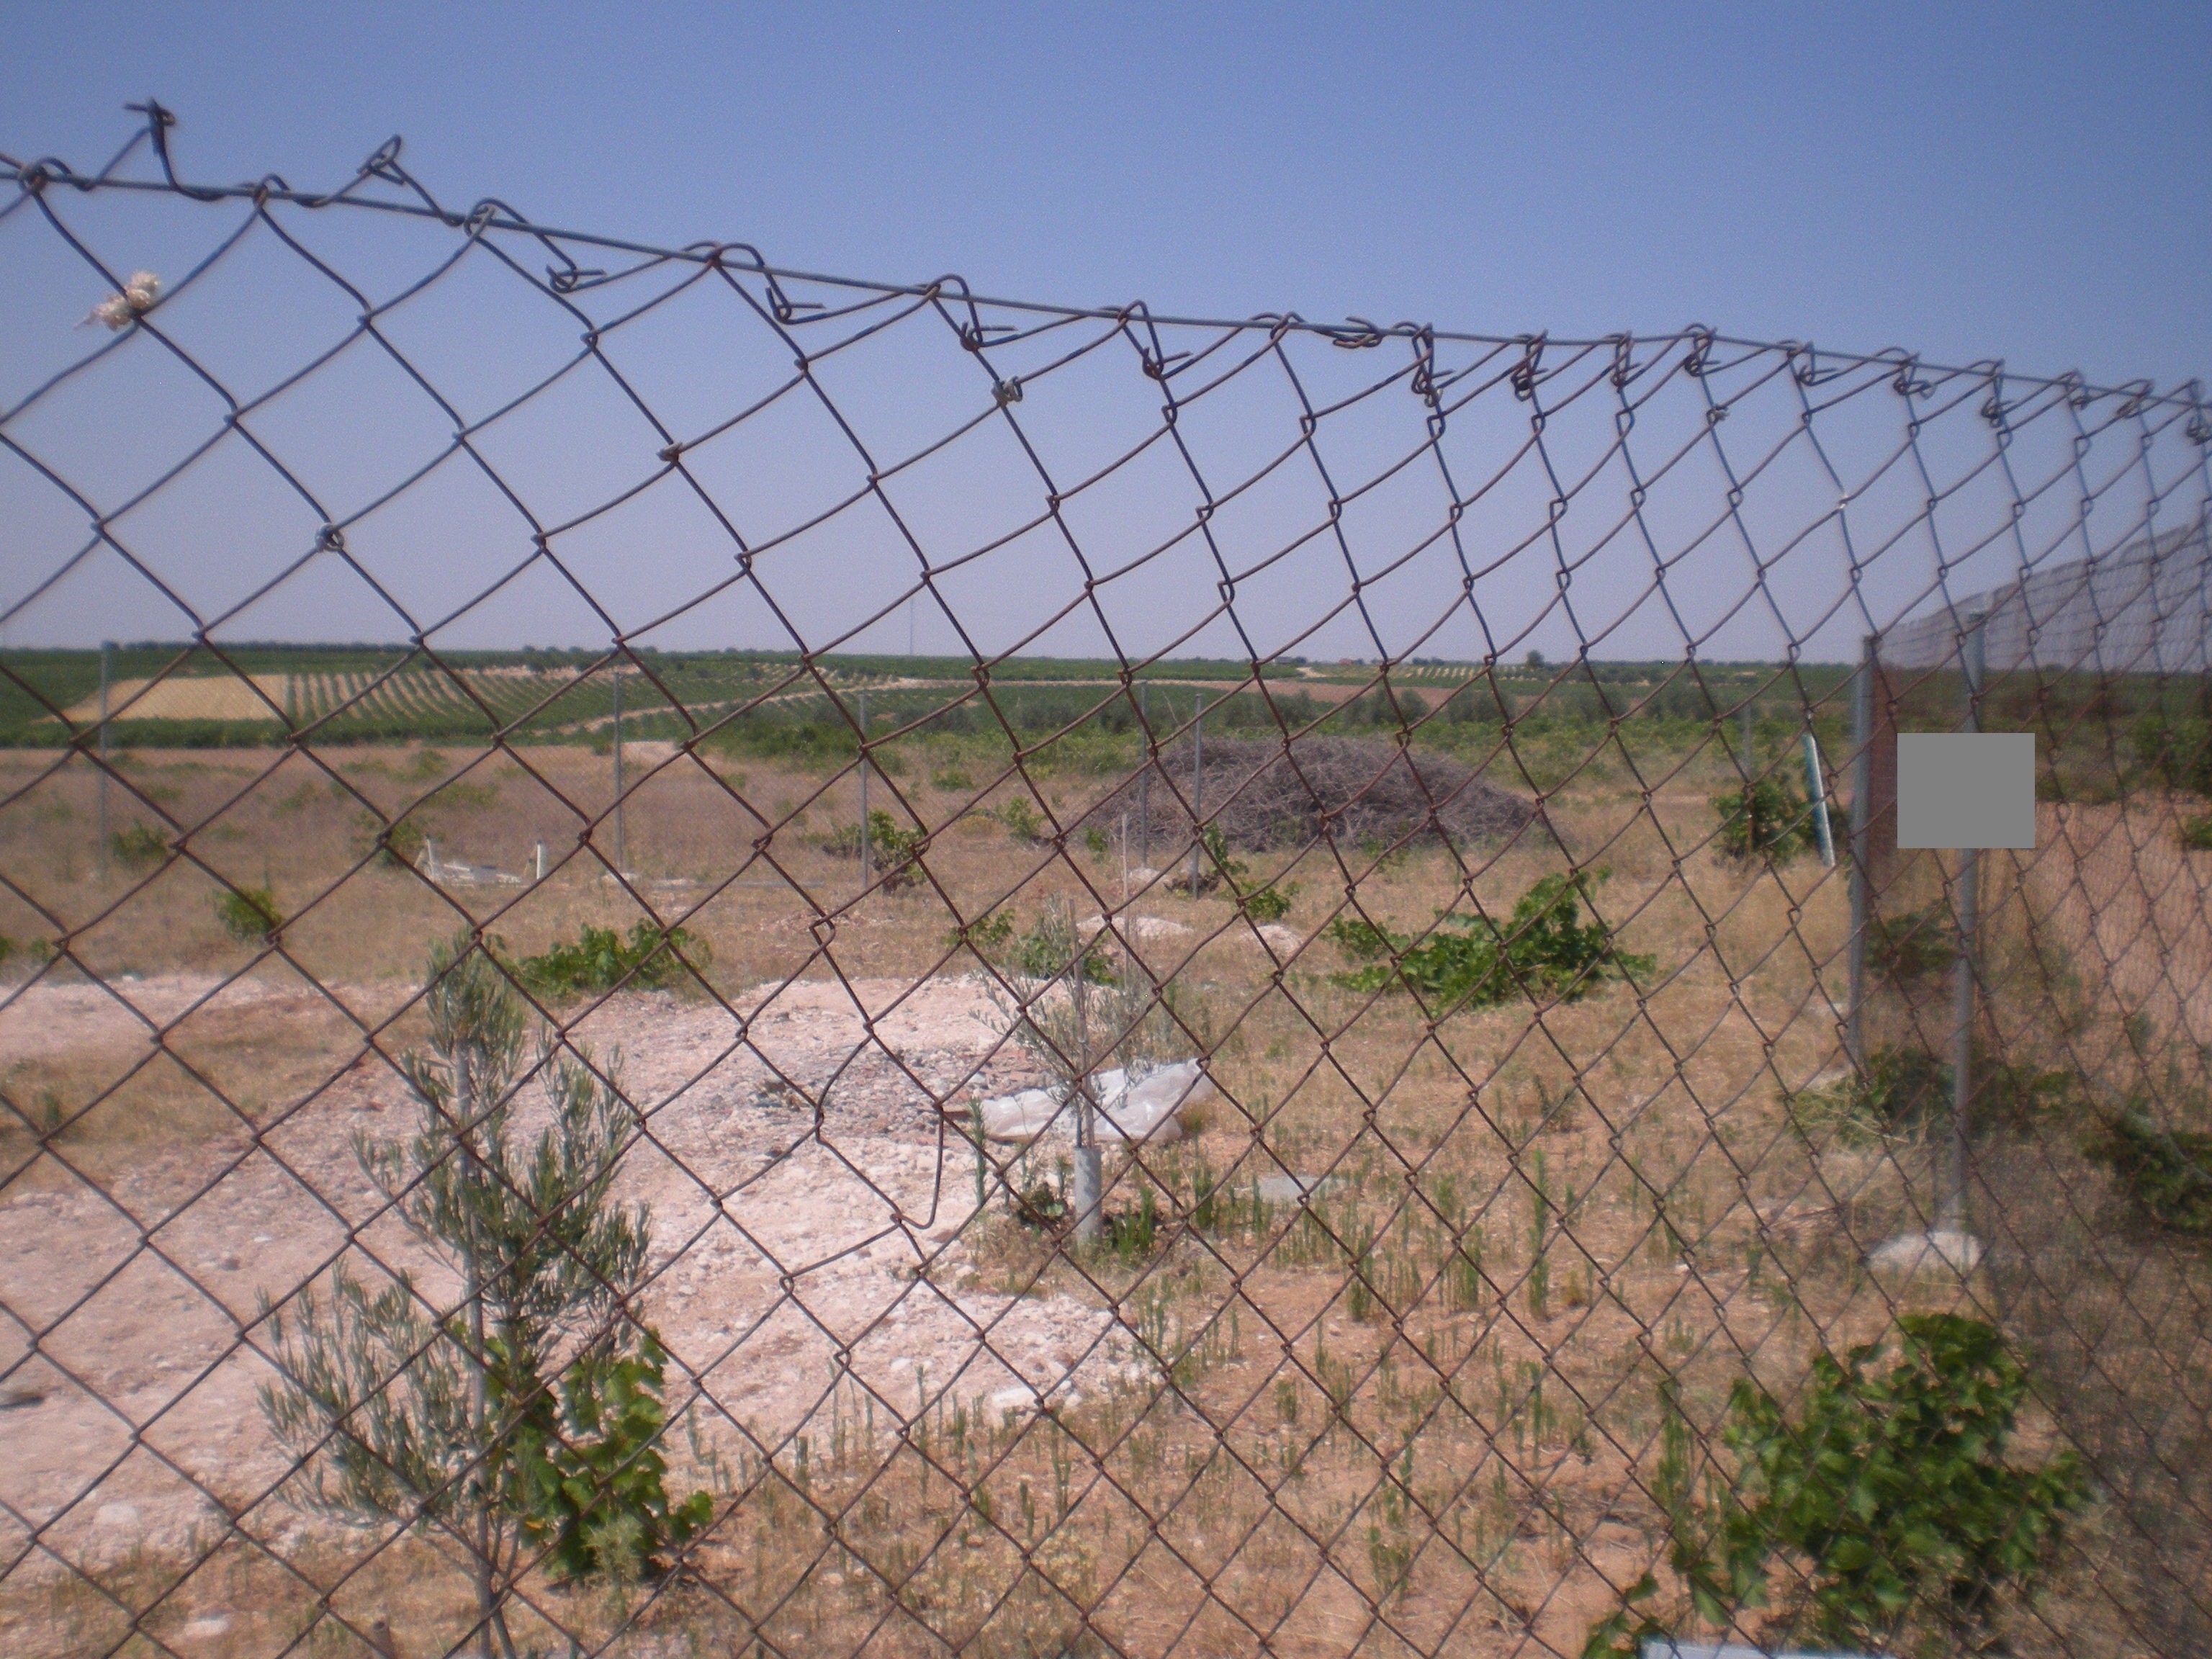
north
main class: Cropland
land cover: Olive groves
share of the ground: < 10 %
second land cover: Spontaneously vegetated surfaces
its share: 10 - 25 %
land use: Agriculture (excluding fallow land and kitchen gardens)
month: July
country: ES
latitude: 39.6047
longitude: -3.0985
